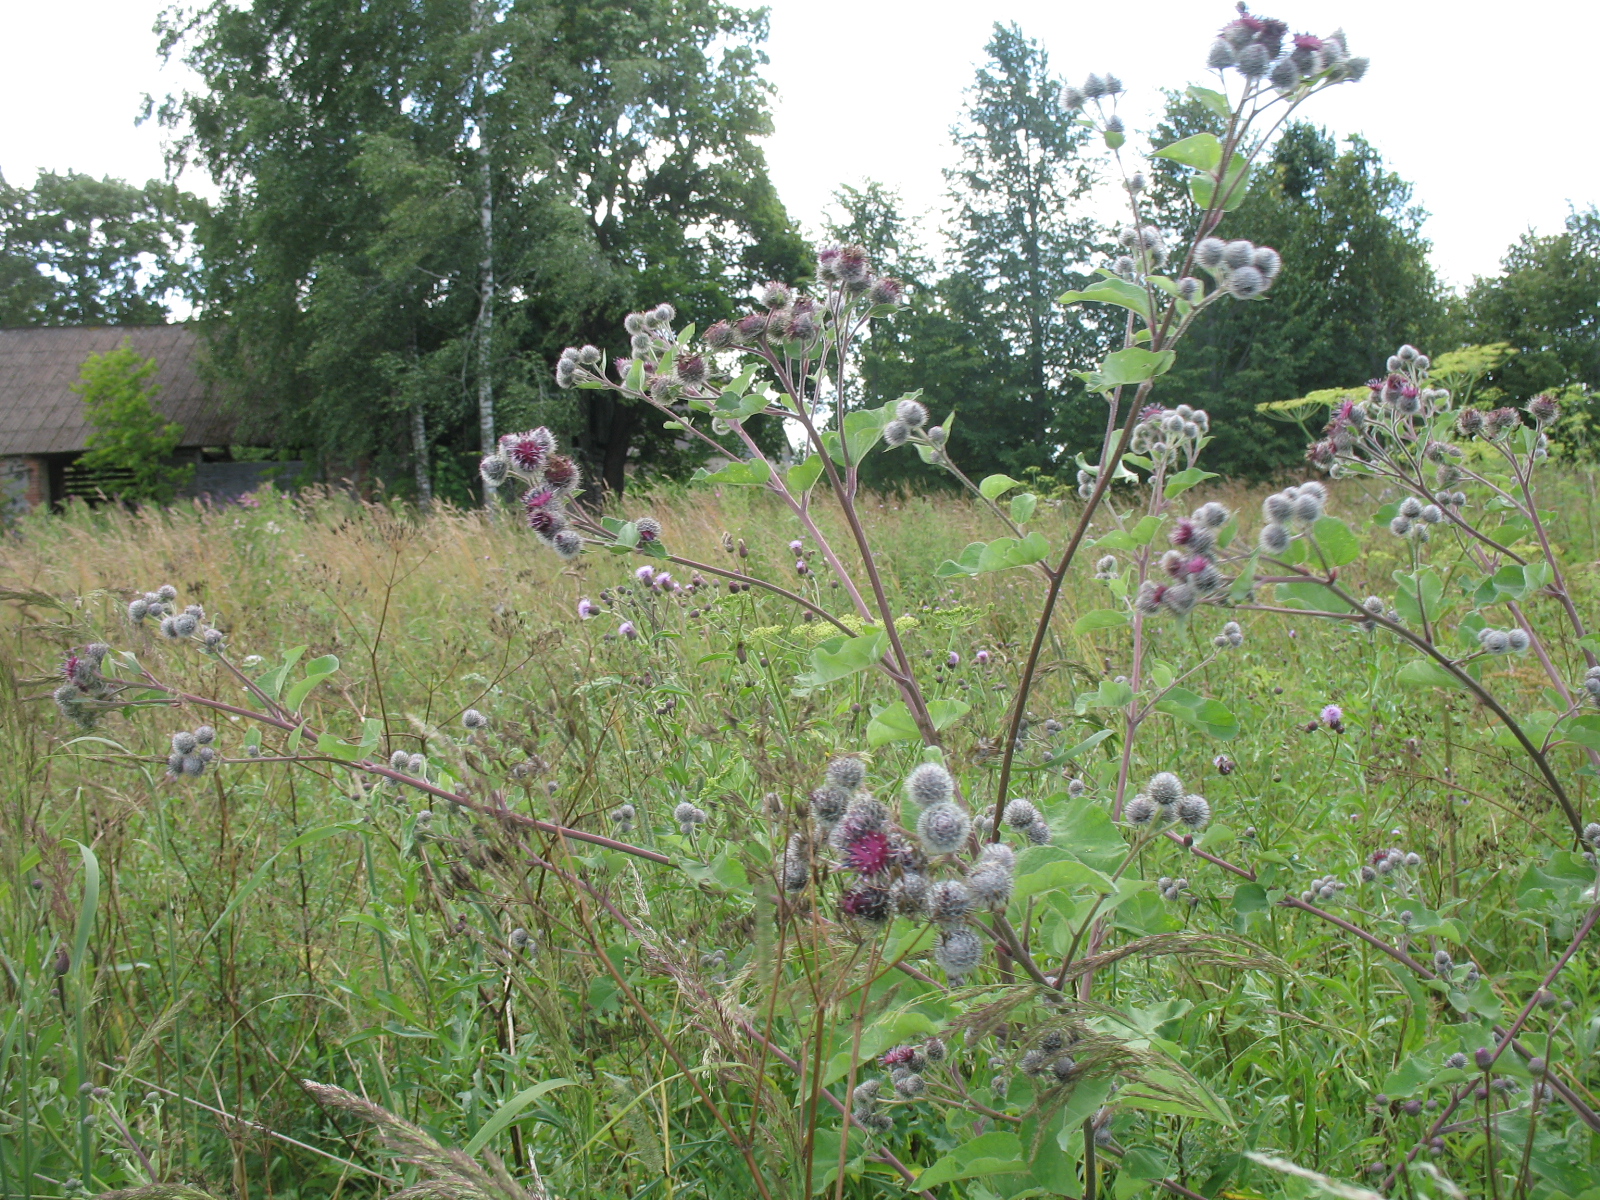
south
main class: Grassland
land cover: Spontaneously vegetated surfaces
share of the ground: > 75 %
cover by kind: herbaceous plants 100 %
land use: Semi-natural and natural areas not in use
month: July
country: LV
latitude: 56.2925
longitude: 25.1215
